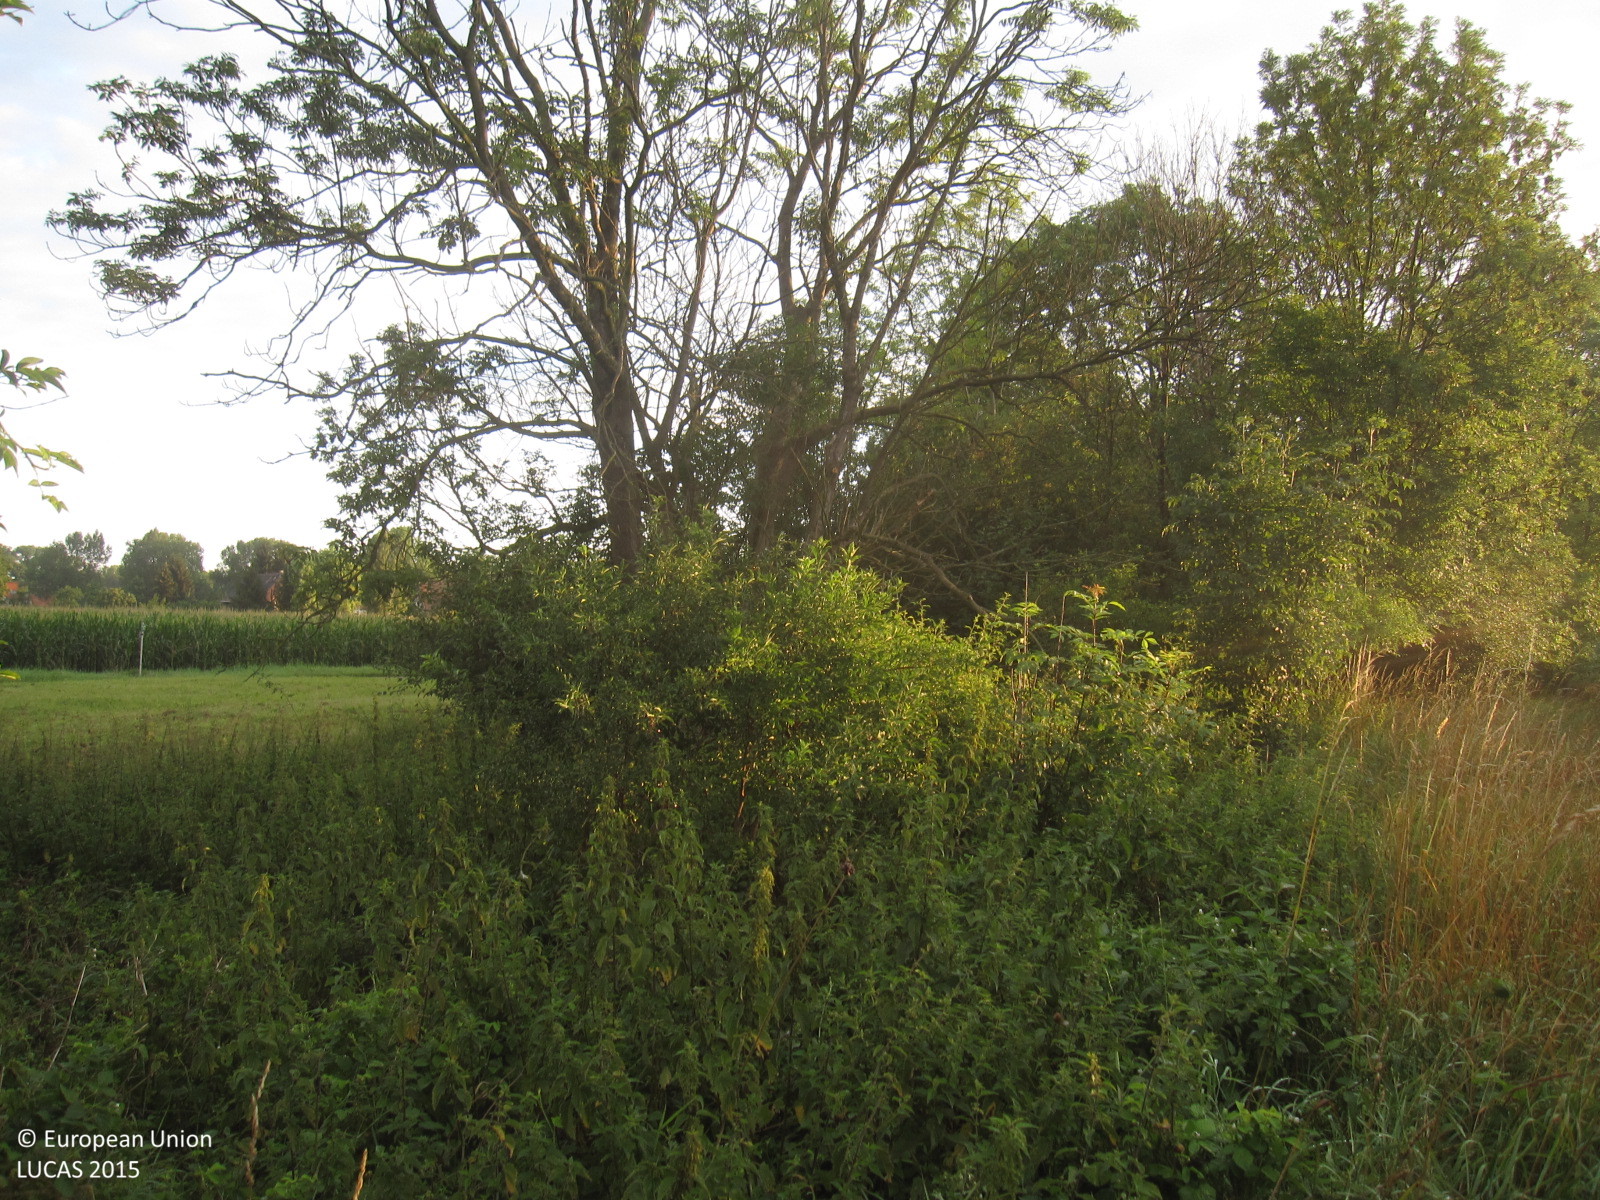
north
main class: Cropland
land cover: Maize
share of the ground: > 75 %
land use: Agriculture (excluding fallow land and kitchen gardens)
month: July
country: DE
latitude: 51.0807
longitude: 12.1837
